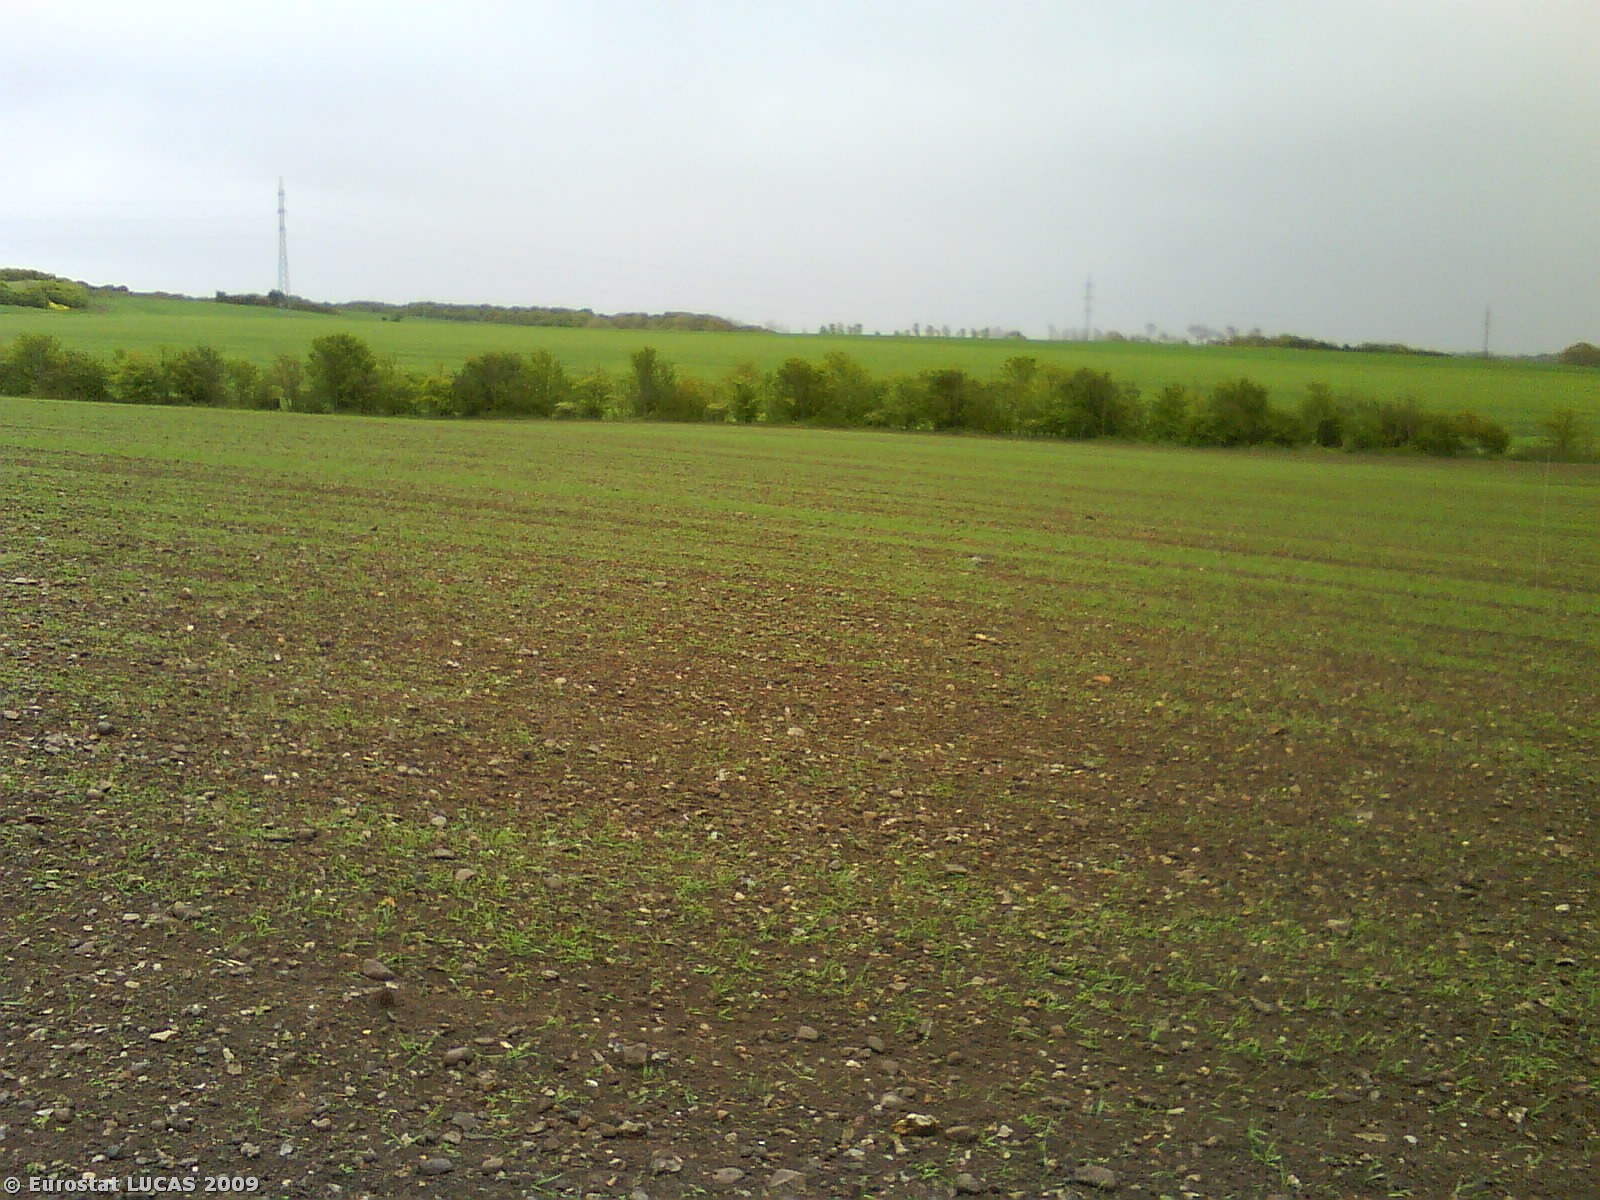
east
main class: Grassland
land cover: Grassland without tree/shrub cover
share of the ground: > 75 %
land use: Agriculture (excluding fallow land and kitchen gardens)
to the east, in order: Grassland without tree/shrub cover; Grass margins; Lines of trees; Grass margins; Common wheat; Broadleaved woodland; Rye
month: May
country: DK
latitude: 56.4034
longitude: 10.1133
